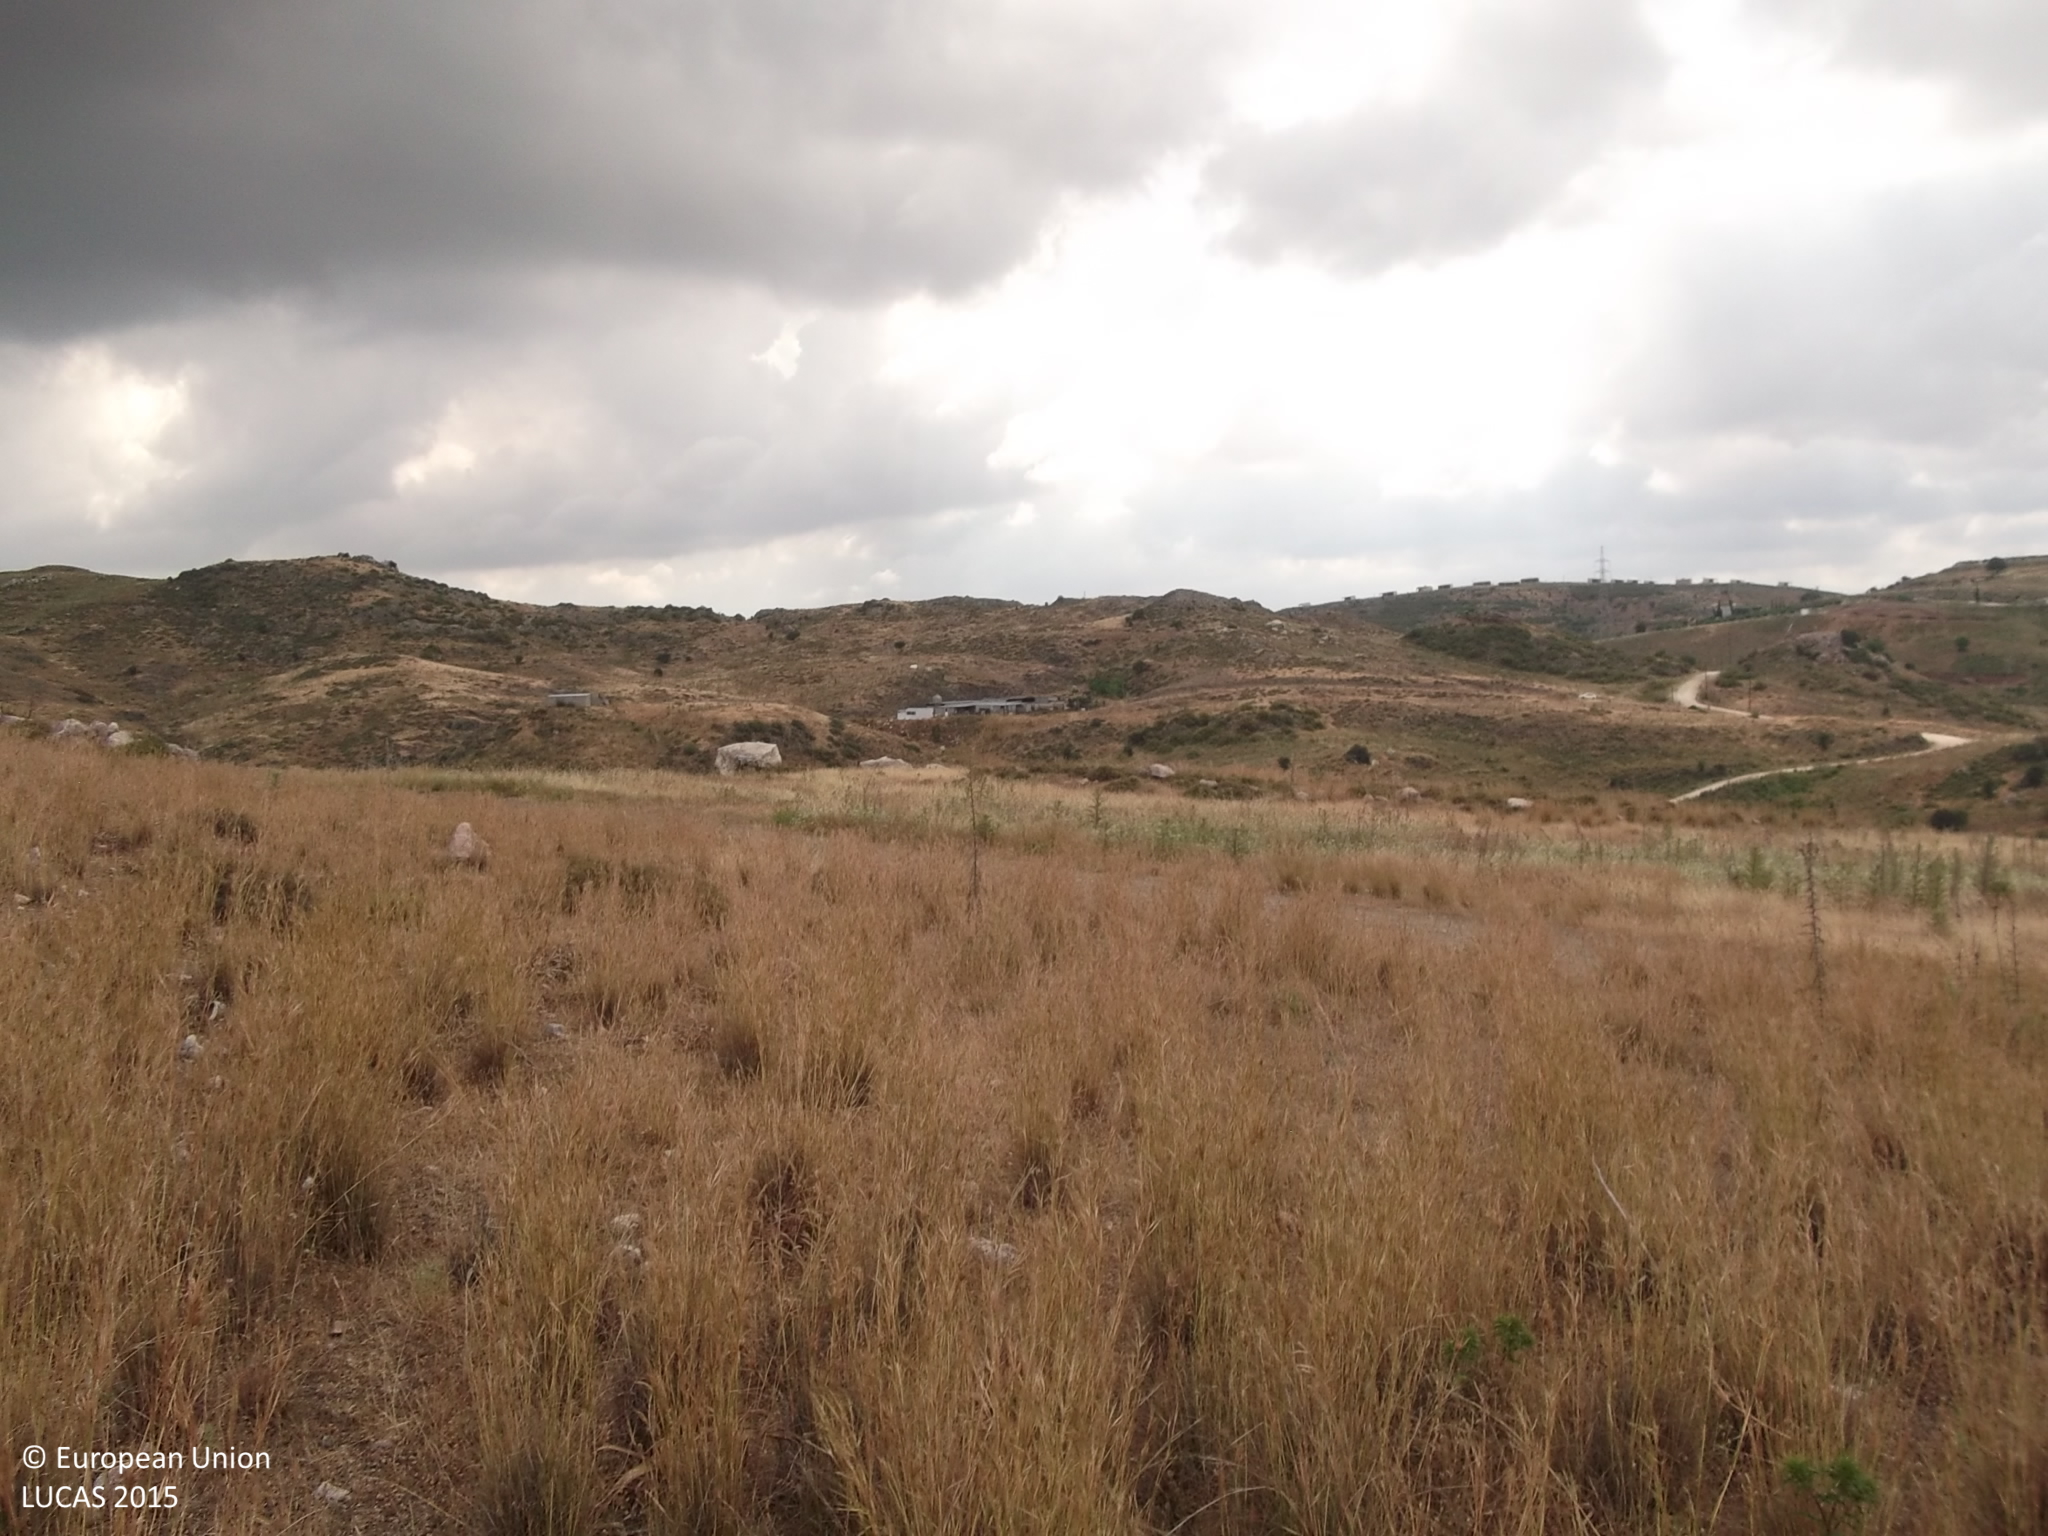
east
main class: Shrubland
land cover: Shrubland without tree cover
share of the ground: 25 - 50 %
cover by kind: herbaceous plants 50 %, shrubs 30 %, unconsolidated bare surface 20 %
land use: Semi-natural and natural areas not in use
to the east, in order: Shrubland without tree cover; Tracks; Shrubland without tree cover
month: May
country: CY
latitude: 34.7620
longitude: 32.5341
